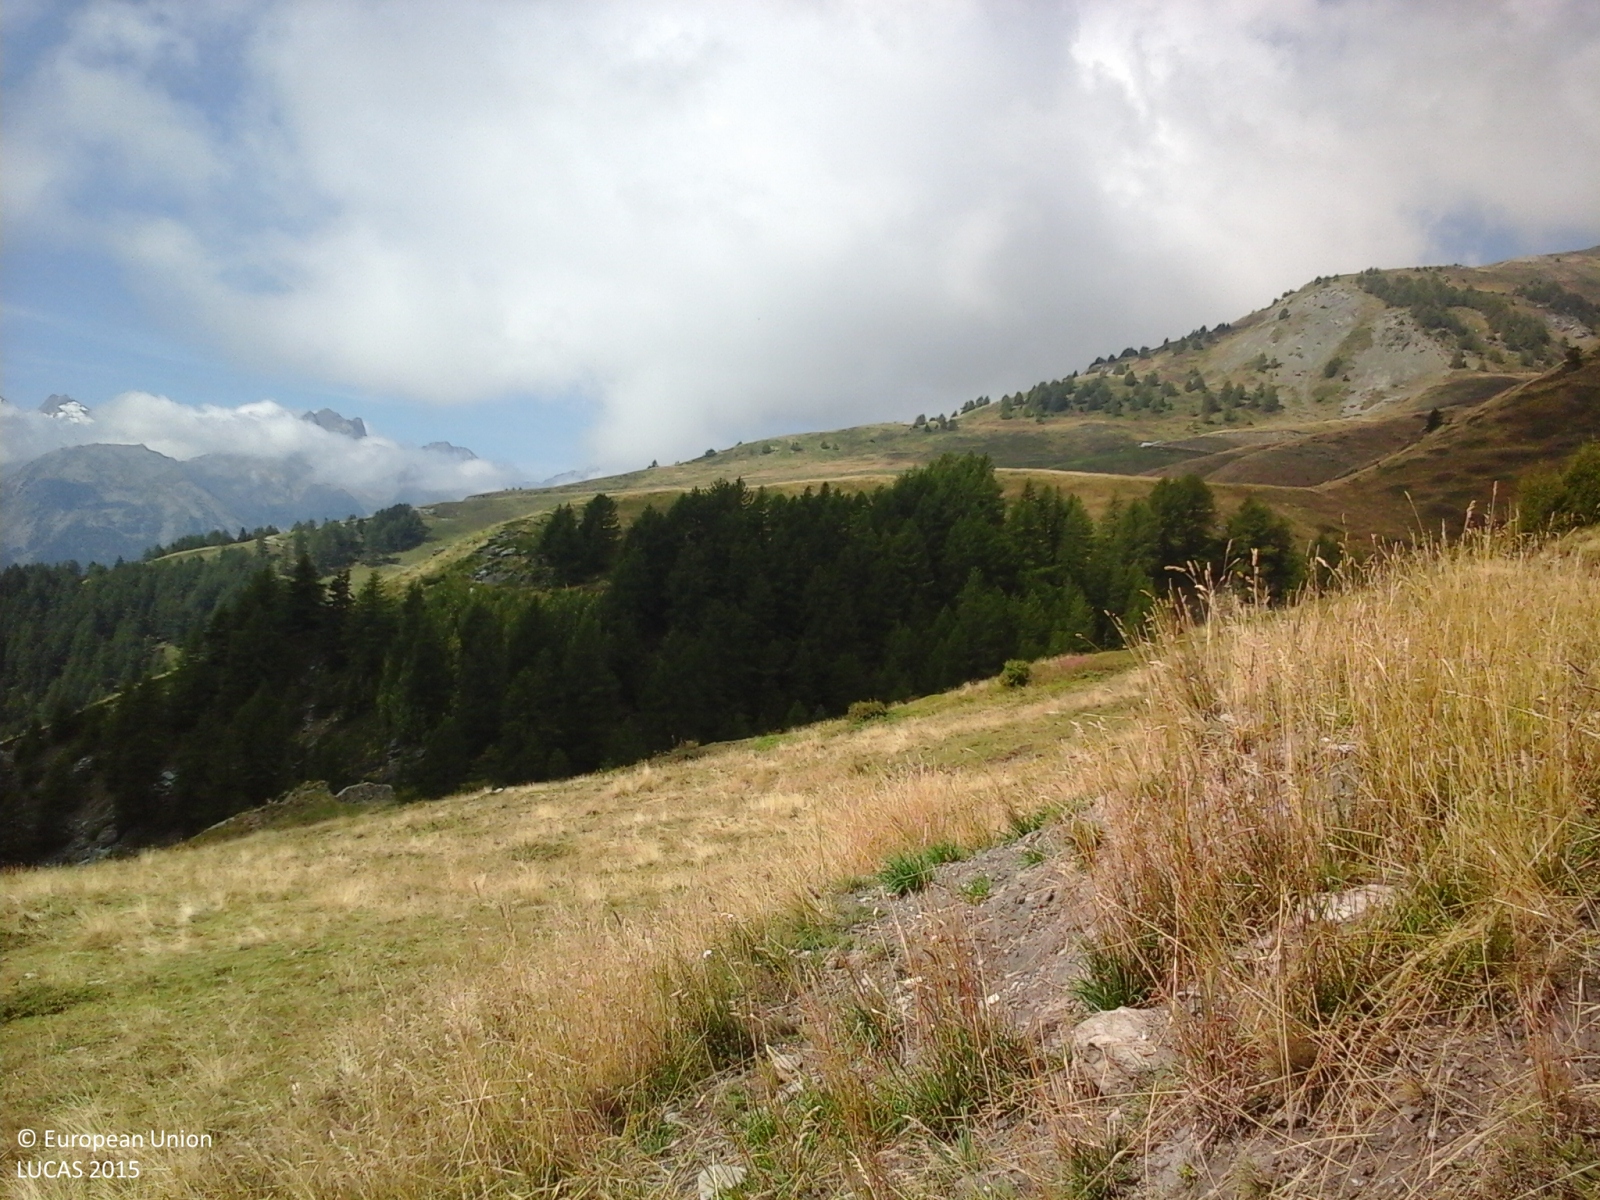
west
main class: Grassland
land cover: Grassland without tree/shrub cover
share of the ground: > 75 %
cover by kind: herbaceous plants 100 %
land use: Agriculture (excluding fallow land and kitchen gardens)
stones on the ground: < 10 %
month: August
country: IT
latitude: 45.7368
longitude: 7.1636
